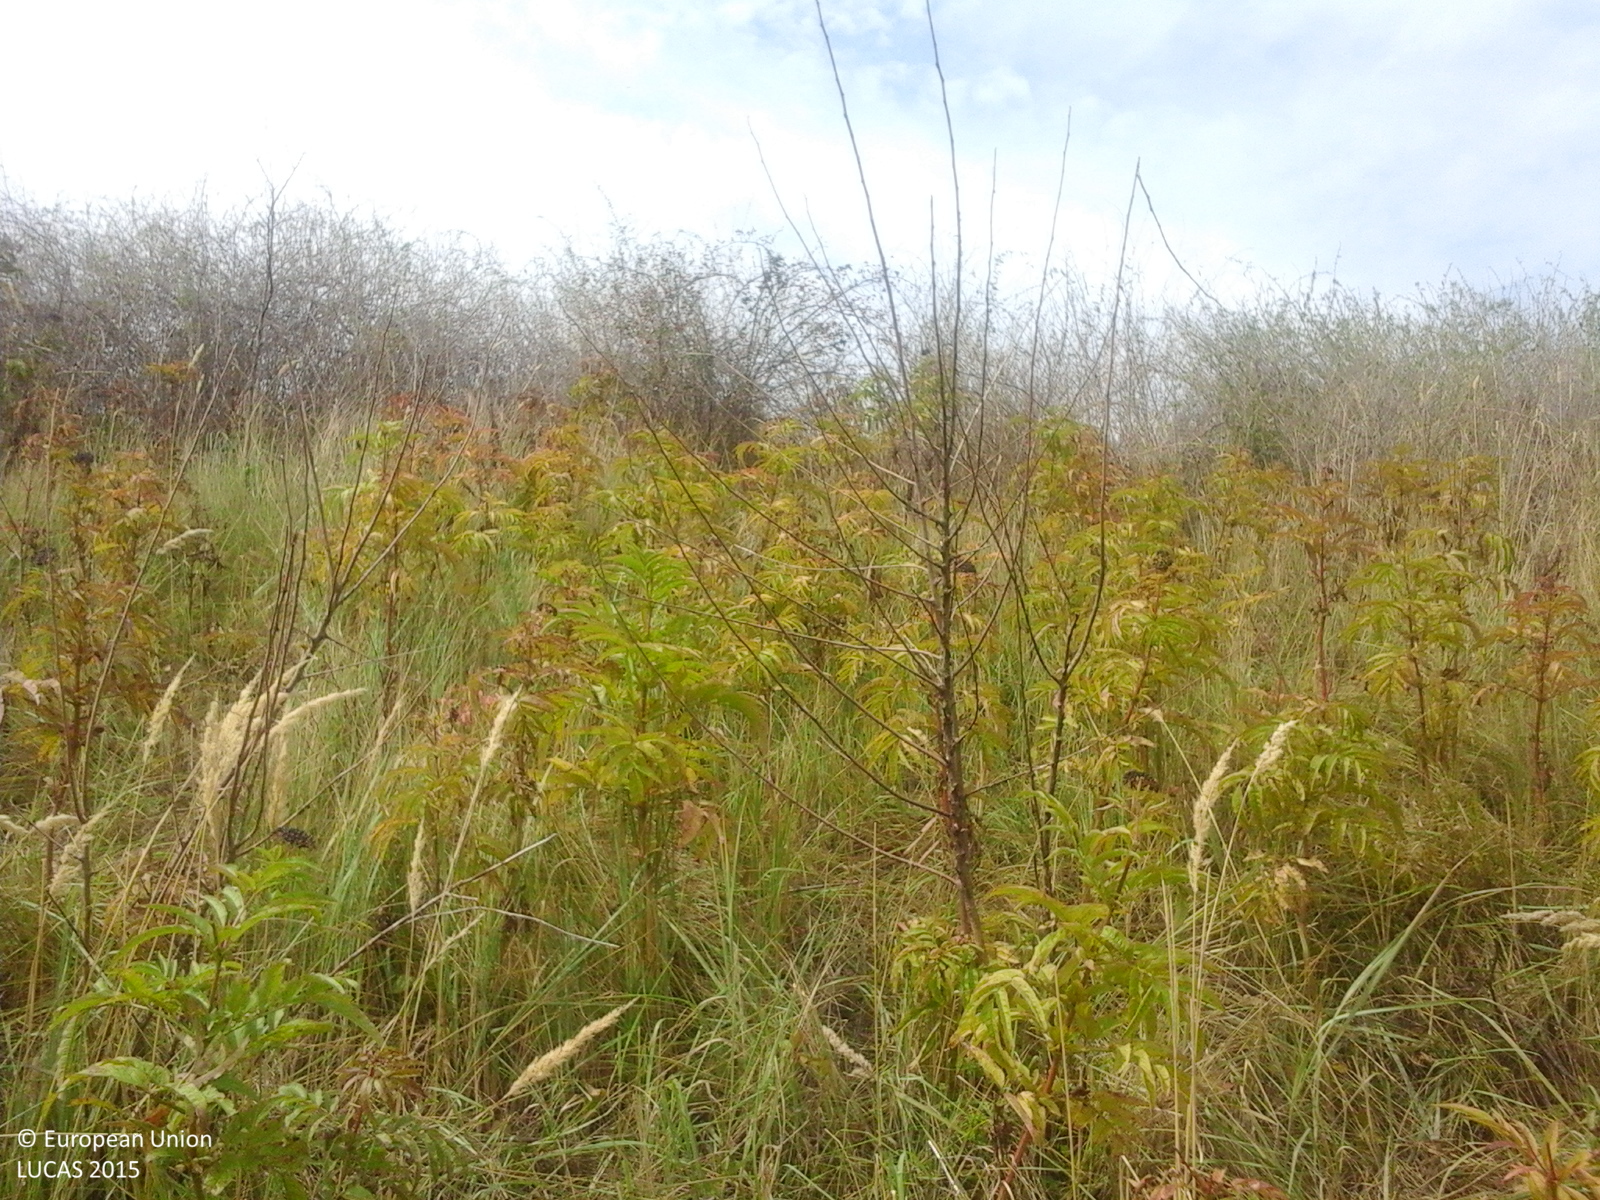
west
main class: Grassland
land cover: Spontaneously vegetated surfaces
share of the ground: > 75 %
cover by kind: herbaceous plants 100 %
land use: Fallow land
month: August
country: RO
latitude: 46.1365
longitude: 21.5963
